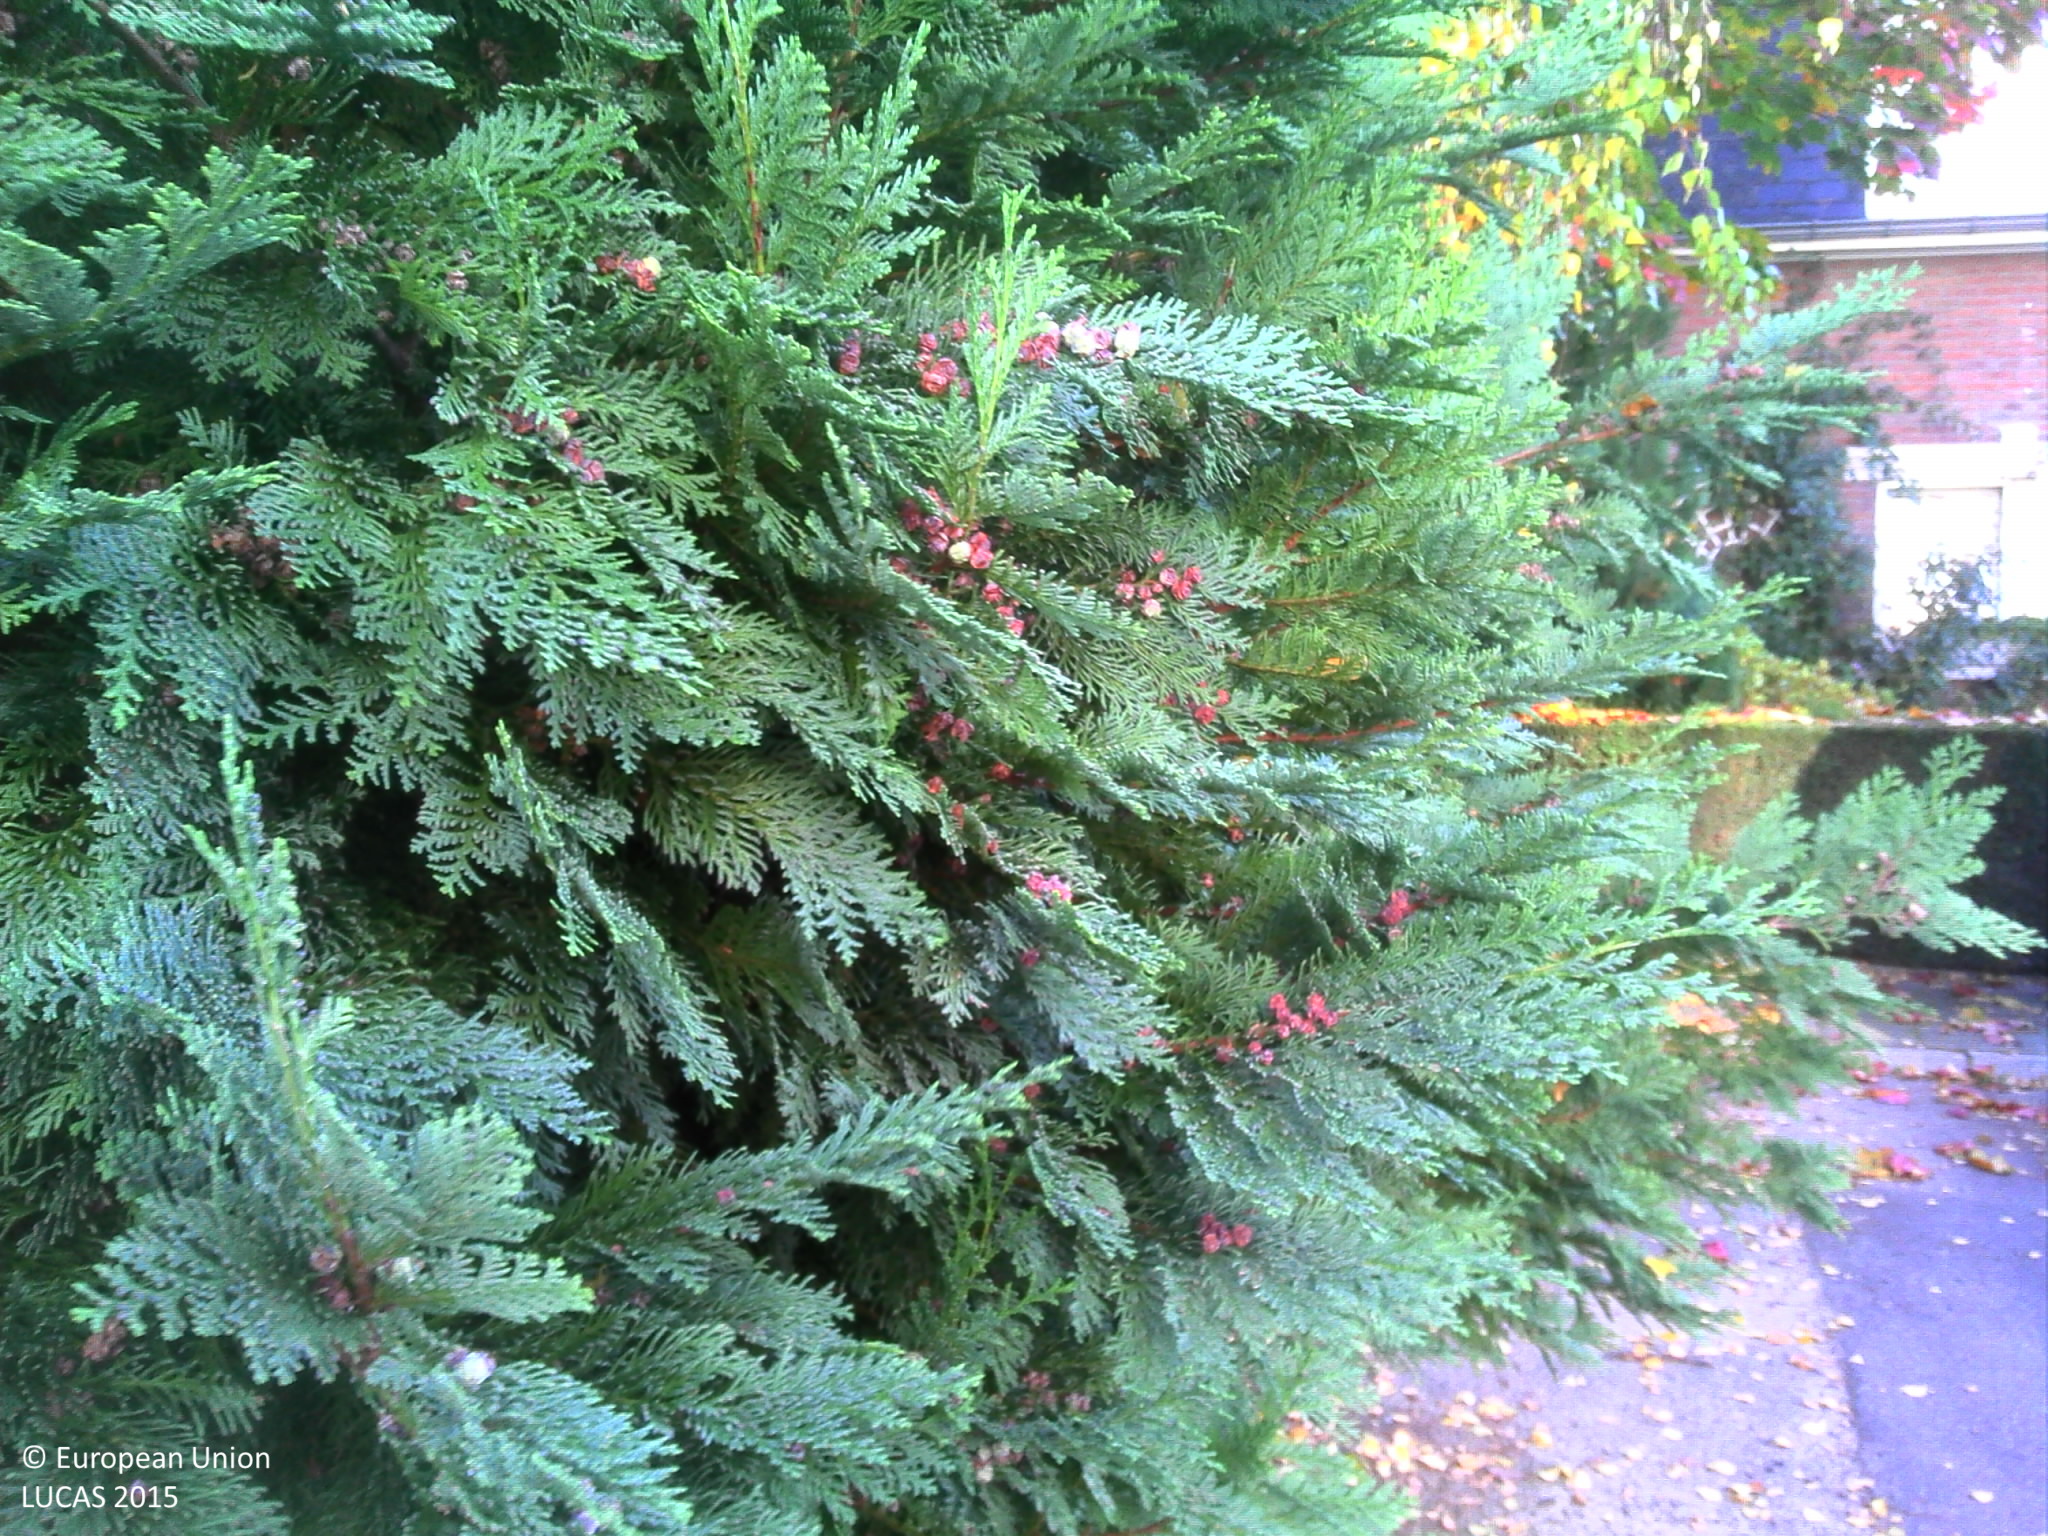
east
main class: Grassland
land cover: Grassland with sparse tree/shrub cover
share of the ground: > 75 %
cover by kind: herbaceous plants 85 %, shrubs 10 %, coniferous forest trees 5 %
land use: Residential
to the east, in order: Grassland with sparse tree/shrub cover; Managed hedges; Grassland without tree/shrub cover; Managed hedges; Grassland without tree/shrub cover; Broadleaved woodland; Arable land (only in case pi); Grassland without tree/shrub cover; Artificial constructions in urban areas
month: October
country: BE
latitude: 50.8432
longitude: 4.4712
